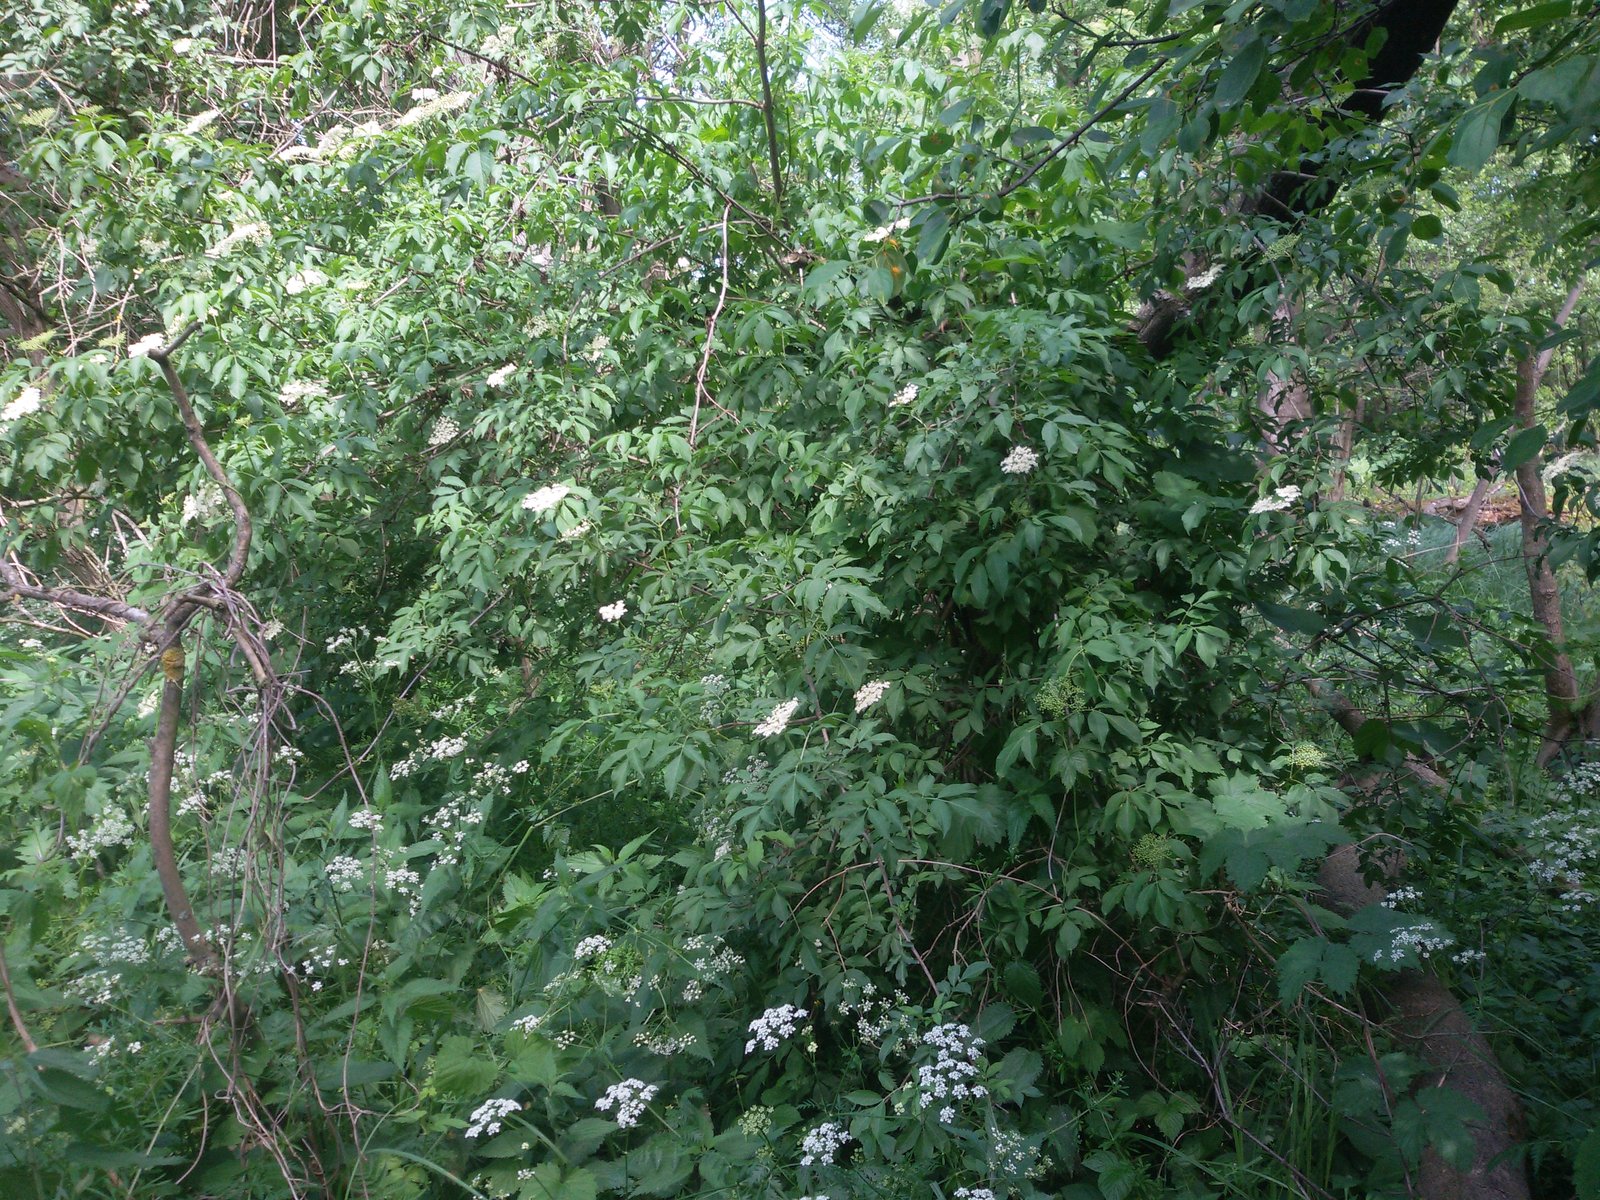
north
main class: Woodland
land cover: Broadleaved woodland
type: mesophytic deciduous forest
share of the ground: > 75 %
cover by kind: broadleaved forest trees 80 %, shrubs 10 %, herbaceous plants 10 %
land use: Semi-natural and natural areas not in use
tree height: > 5 m
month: June
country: PL
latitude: 52.1019
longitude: 16.9442
